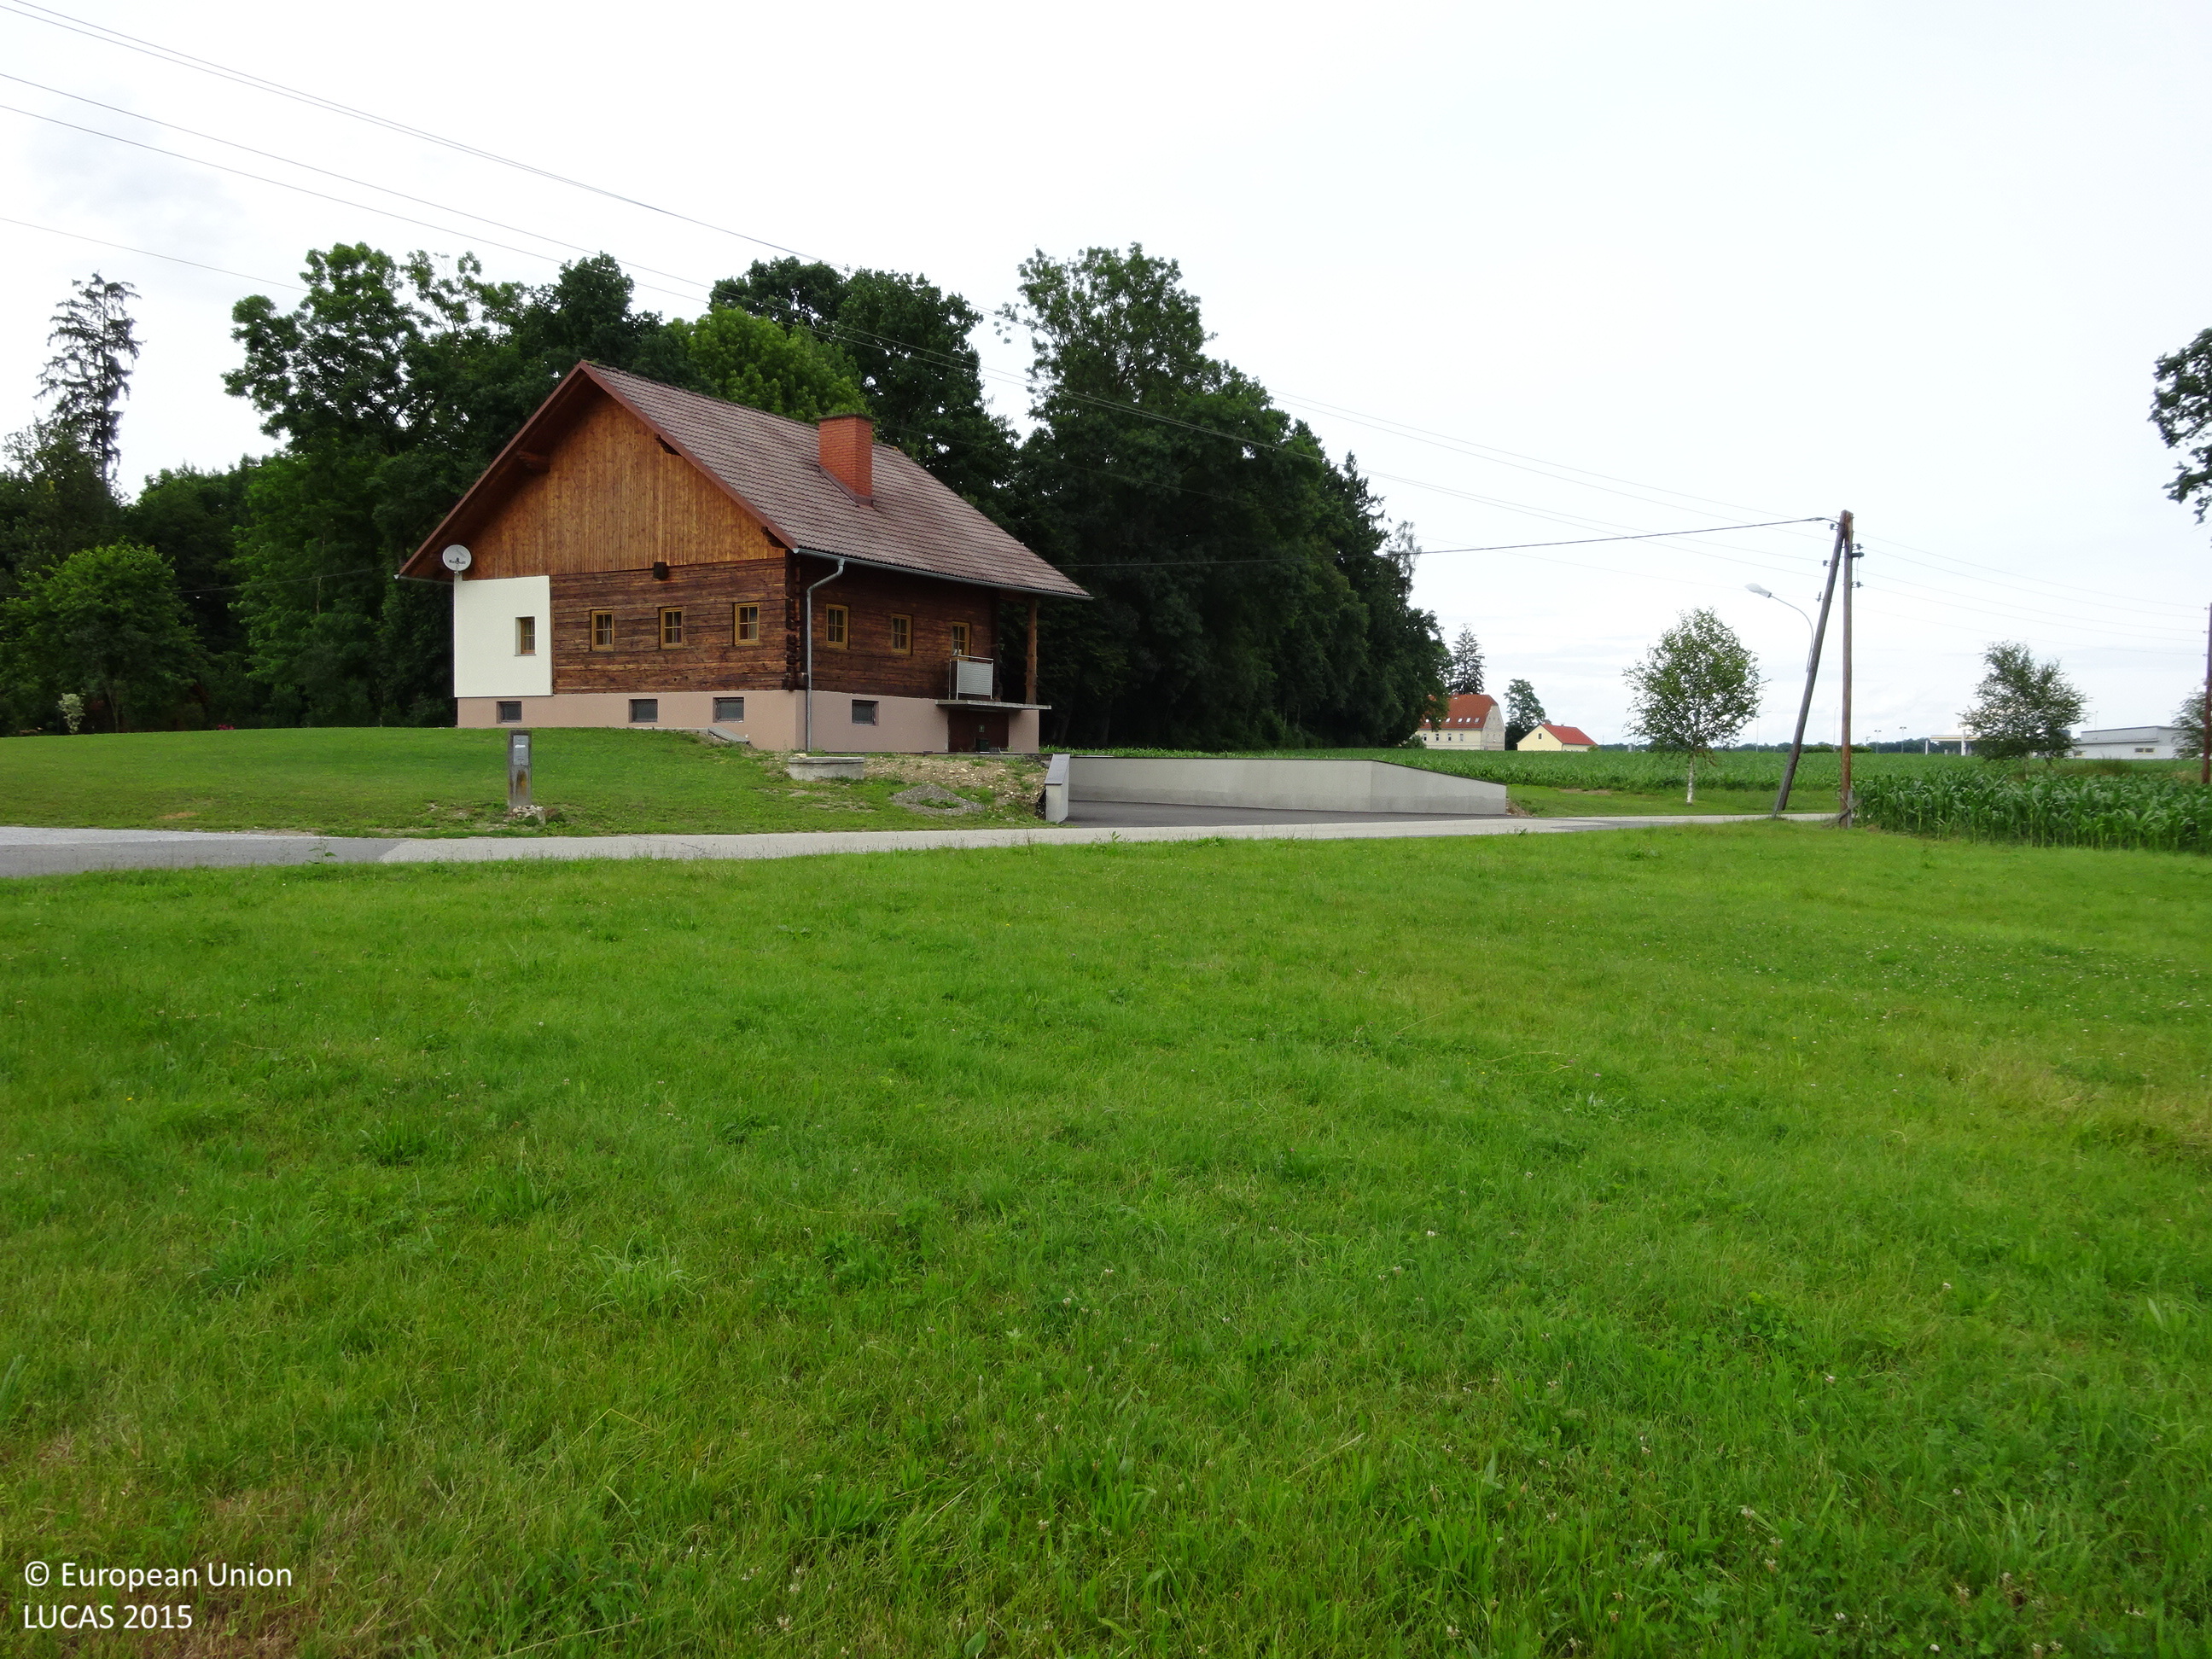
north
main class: Grassland
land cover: Grassland without tree/shrub cover
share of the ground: > 75 %
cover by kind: herbaceous plants 100 %
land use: Agriculture (excluding fallow land and kitchen gardens)
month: June
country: AT
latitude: 46.7273
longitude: 15.6128
